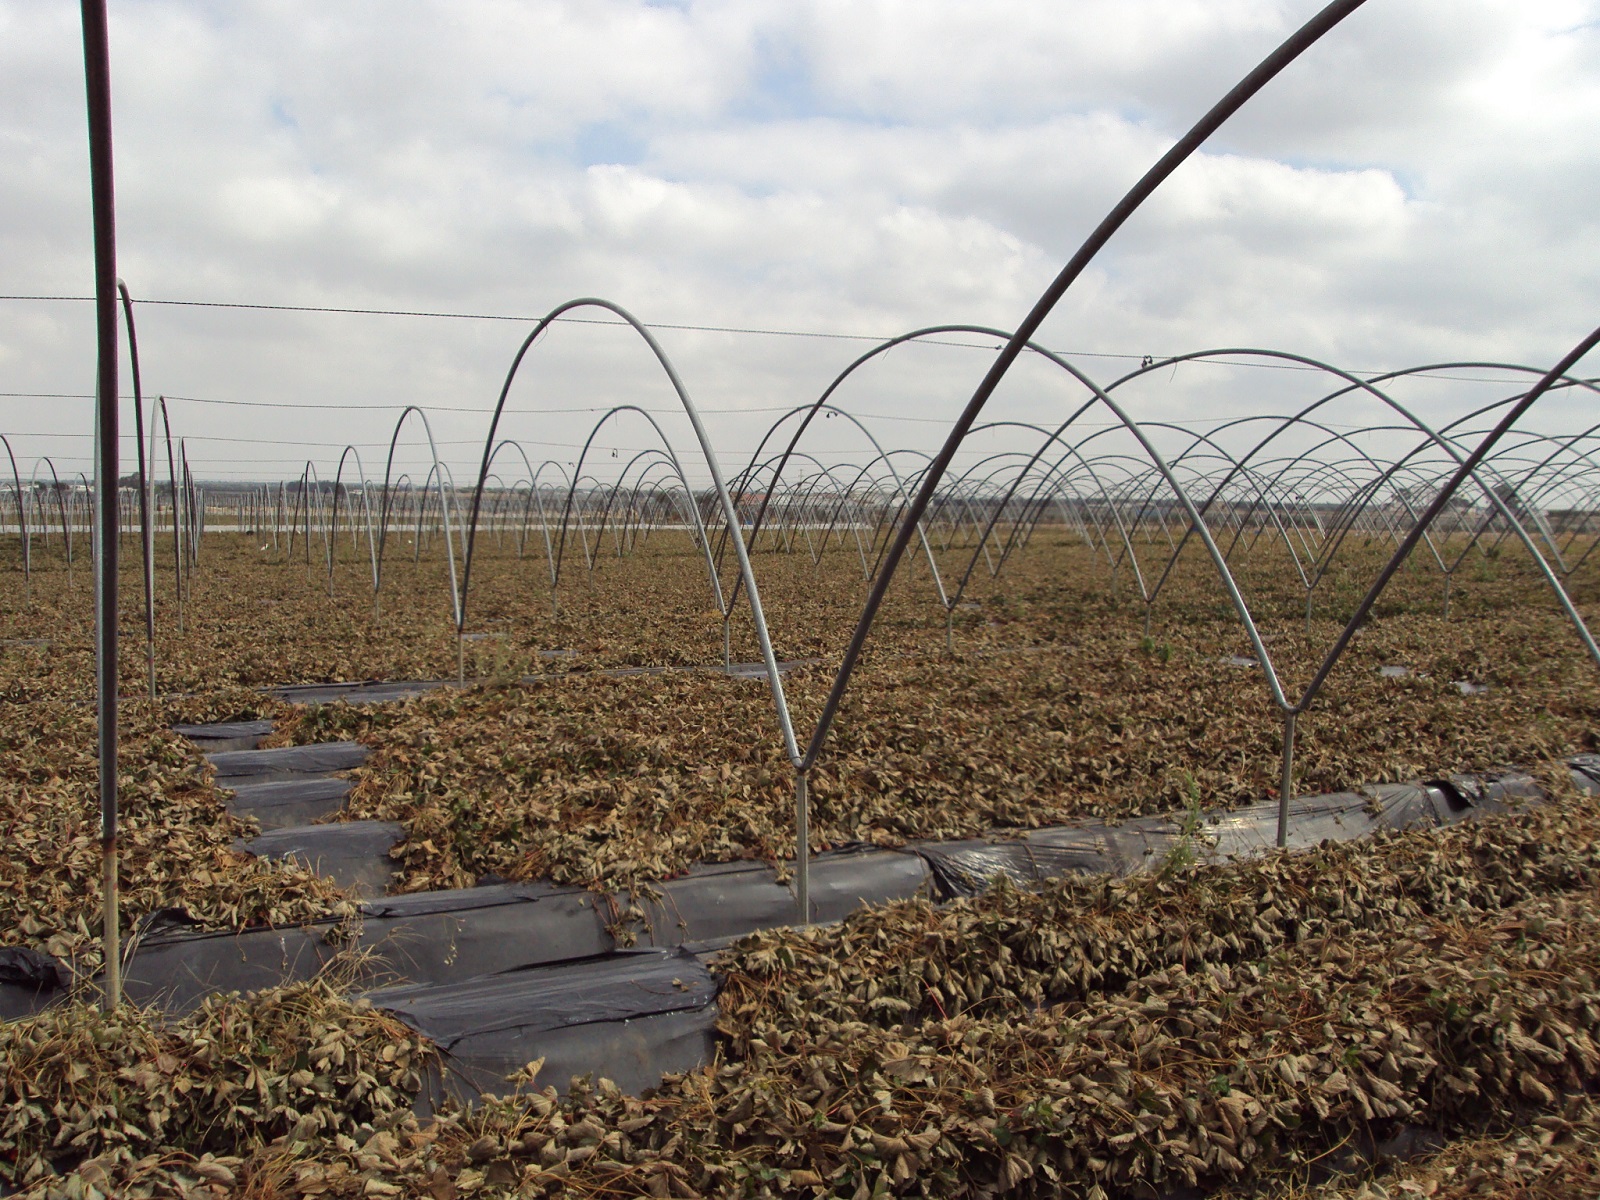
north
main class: Artificial land
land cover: Greenhouses
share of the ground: > 75 %
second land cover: Strawberries
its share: > 75 %
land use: Agriculture (excluding fallow land and kitchen gardens)
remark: Harvested field
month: June
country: ES
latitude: 37.1743
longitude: -6.8499
